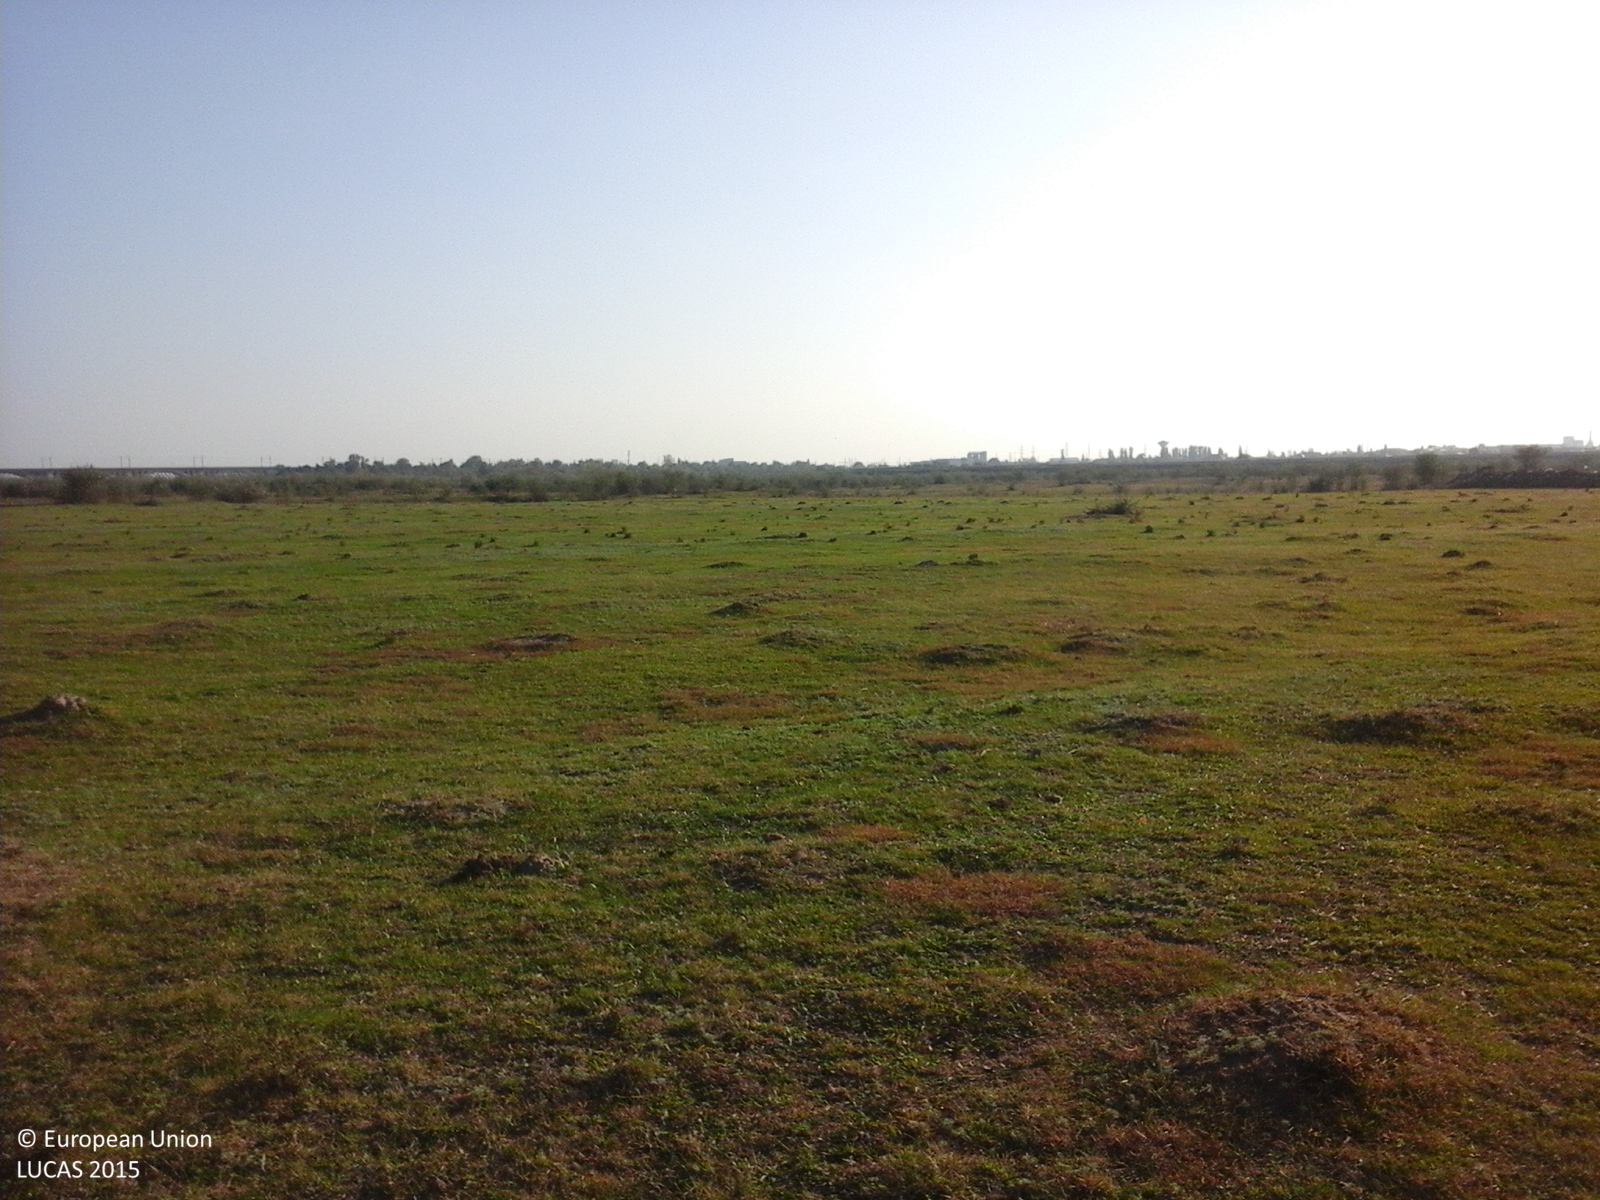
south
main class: Grassland
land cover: Grassland without tree/shrub cover
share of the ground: > 75 %
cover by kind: herbaceous plants 100 %
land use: Agriculture (excluding fallow land and kitchen gardens)
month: October
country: RO
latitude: 45.1656
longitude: 26.8622
